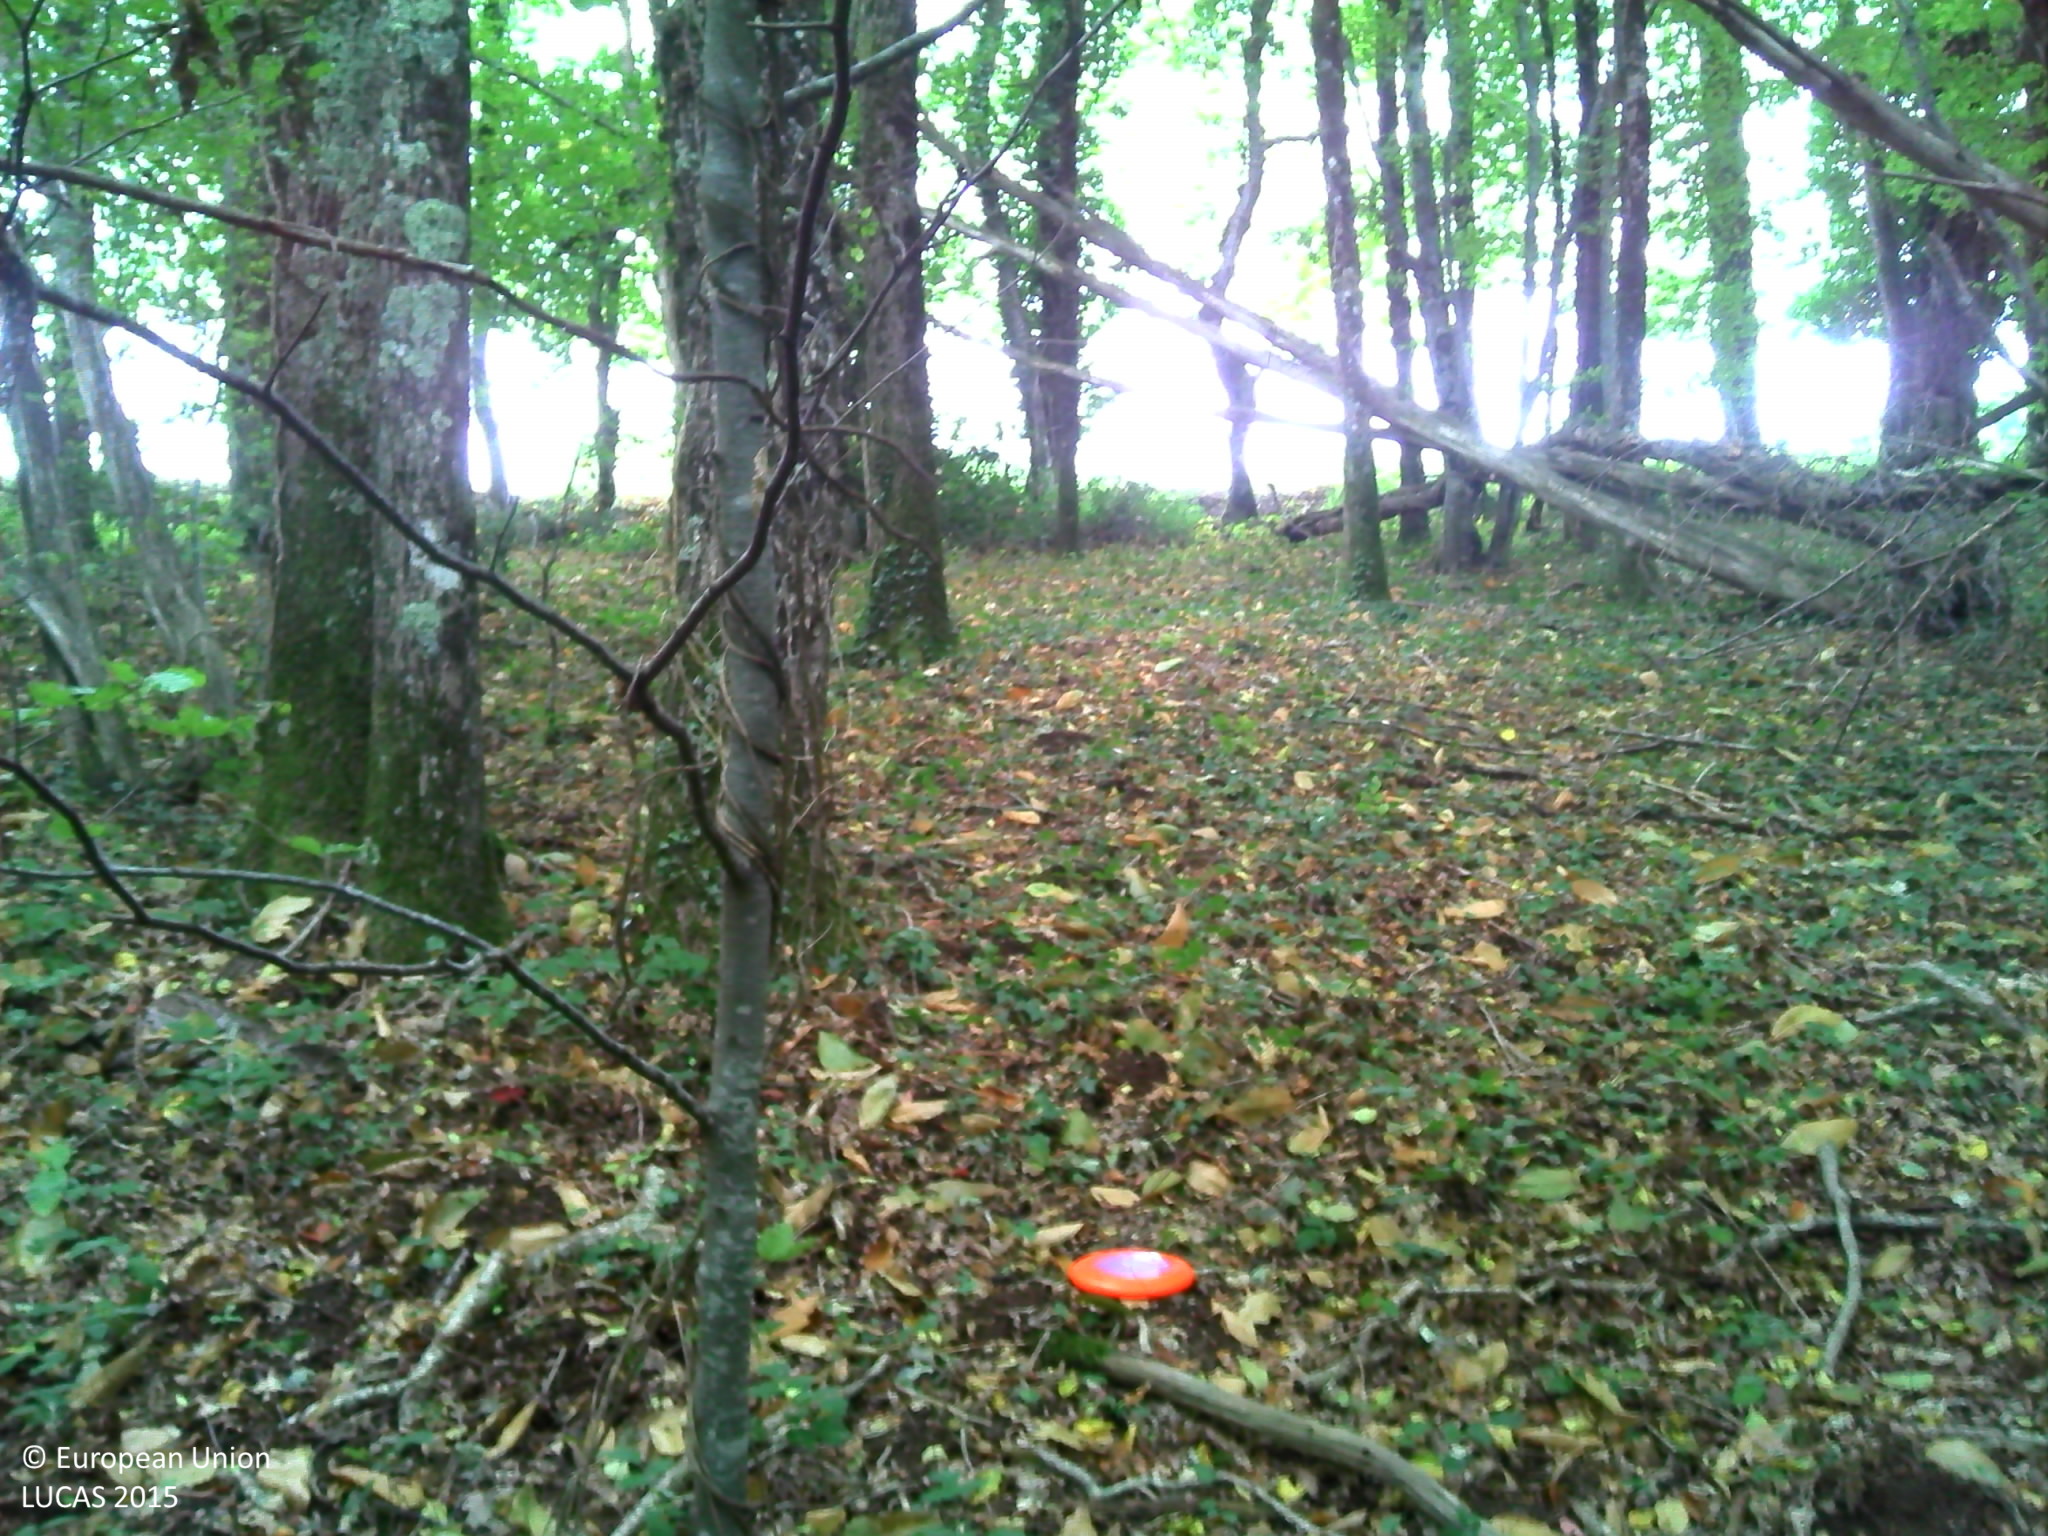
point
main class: Woodland
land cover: Broadleaved woodland
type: mesophytic deciduous forest
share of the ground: > 75 %
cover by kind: broadleaved forest trees 85 %, unconsolidated bare surface 10 %, herbaceous plants 5 %
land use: Forestry
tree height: > 5 m
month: September
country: FR
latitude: 46.4206
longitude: 1.6245
